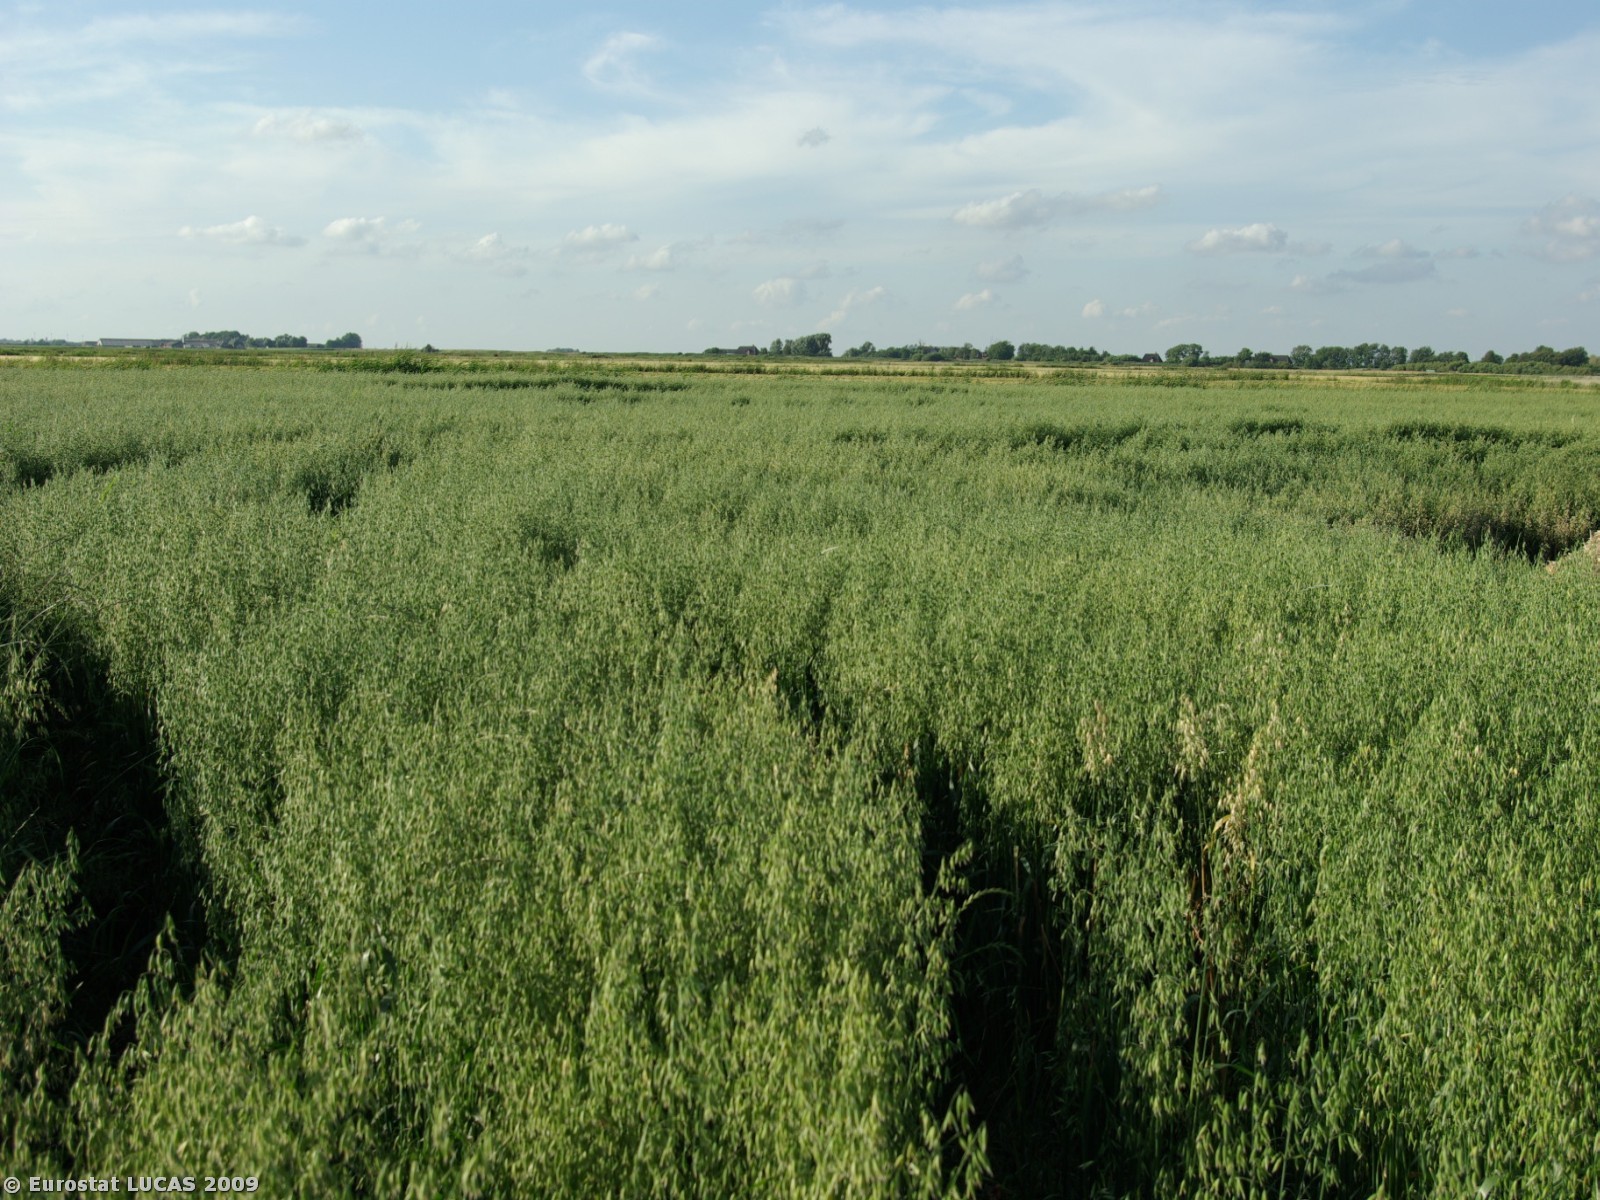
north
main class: Cropland
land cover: Oats
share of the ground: > 75 %
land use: Agriculture (excluding fallow land and kitchen gardens)
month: July
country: DK
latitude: 54.9052
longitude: 8.7376
